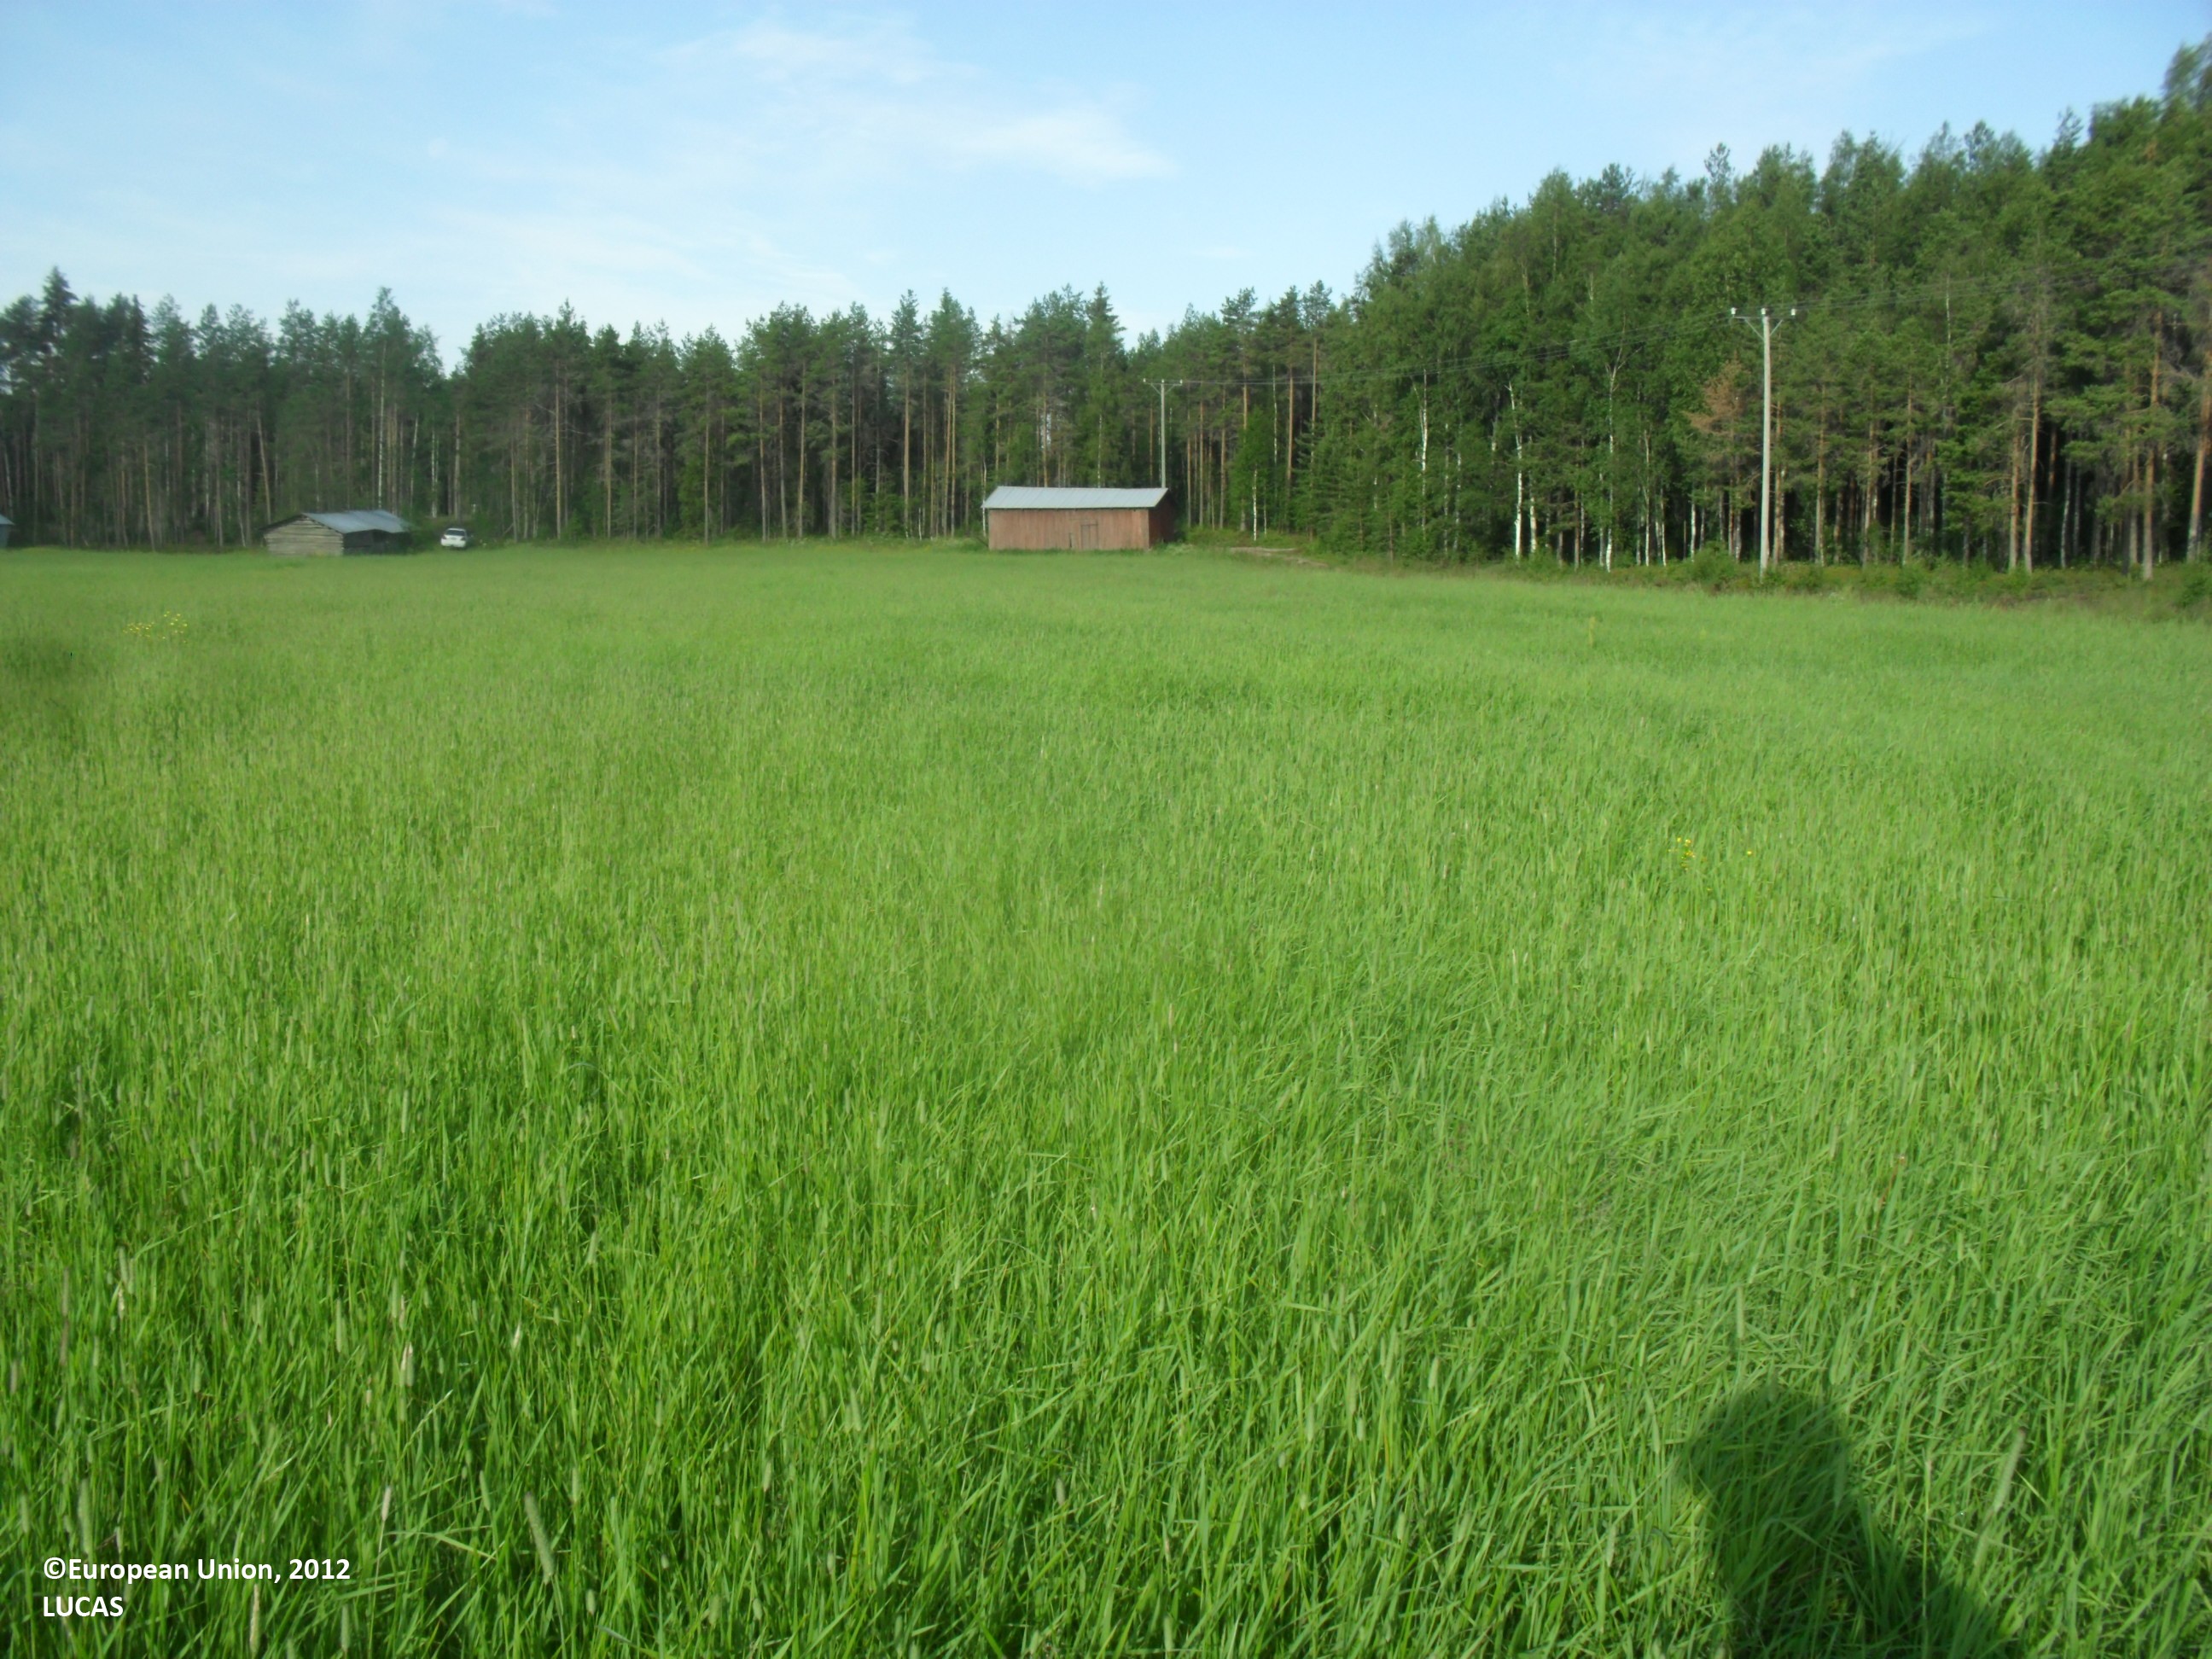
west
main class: Cropland
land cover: Temporary grasslands
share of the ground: > 75 %
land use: Agriculture (excluding fallow land and kitchen gardens)
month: July
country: FI
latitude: 63.5585
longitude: 23.7329
